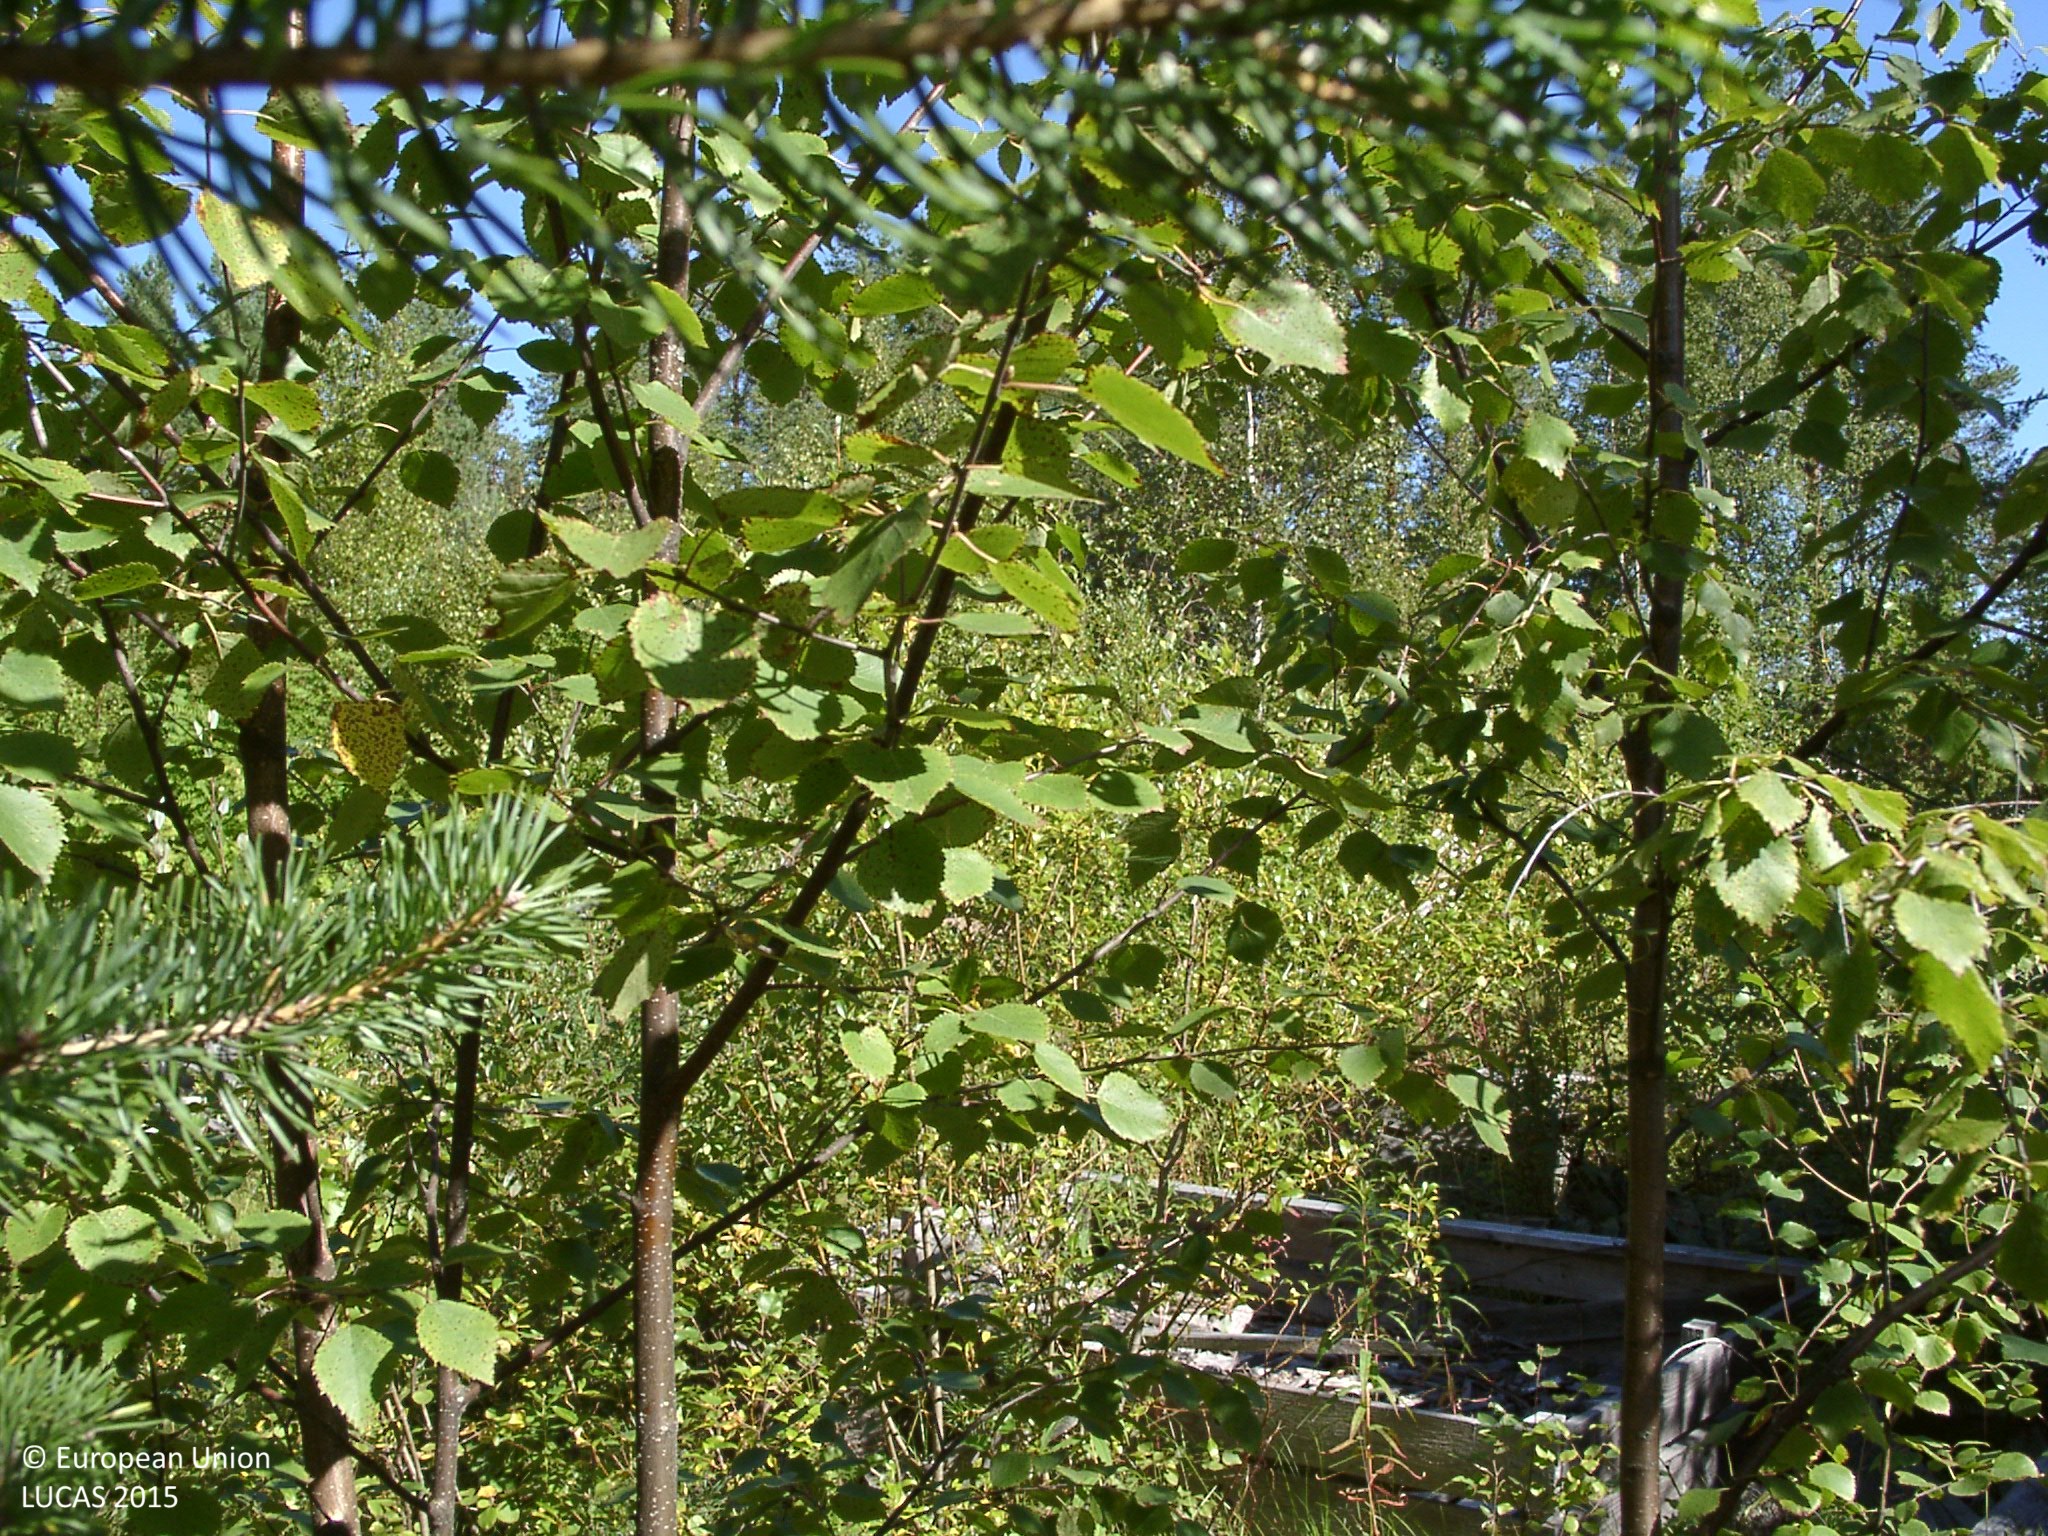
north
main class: Woodland
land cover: Pine dominated mixed woodland
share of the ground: 25 - 50 %
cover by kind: shrubs 25 %, coniferous forest trees 20 %, broadleaved forest trees 10 %, herbaceous plants 10 %, lichens and mosses 5 %
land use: Residential
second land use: Forestry
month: August
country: FI
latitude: 62.4735
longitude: 25.2540
